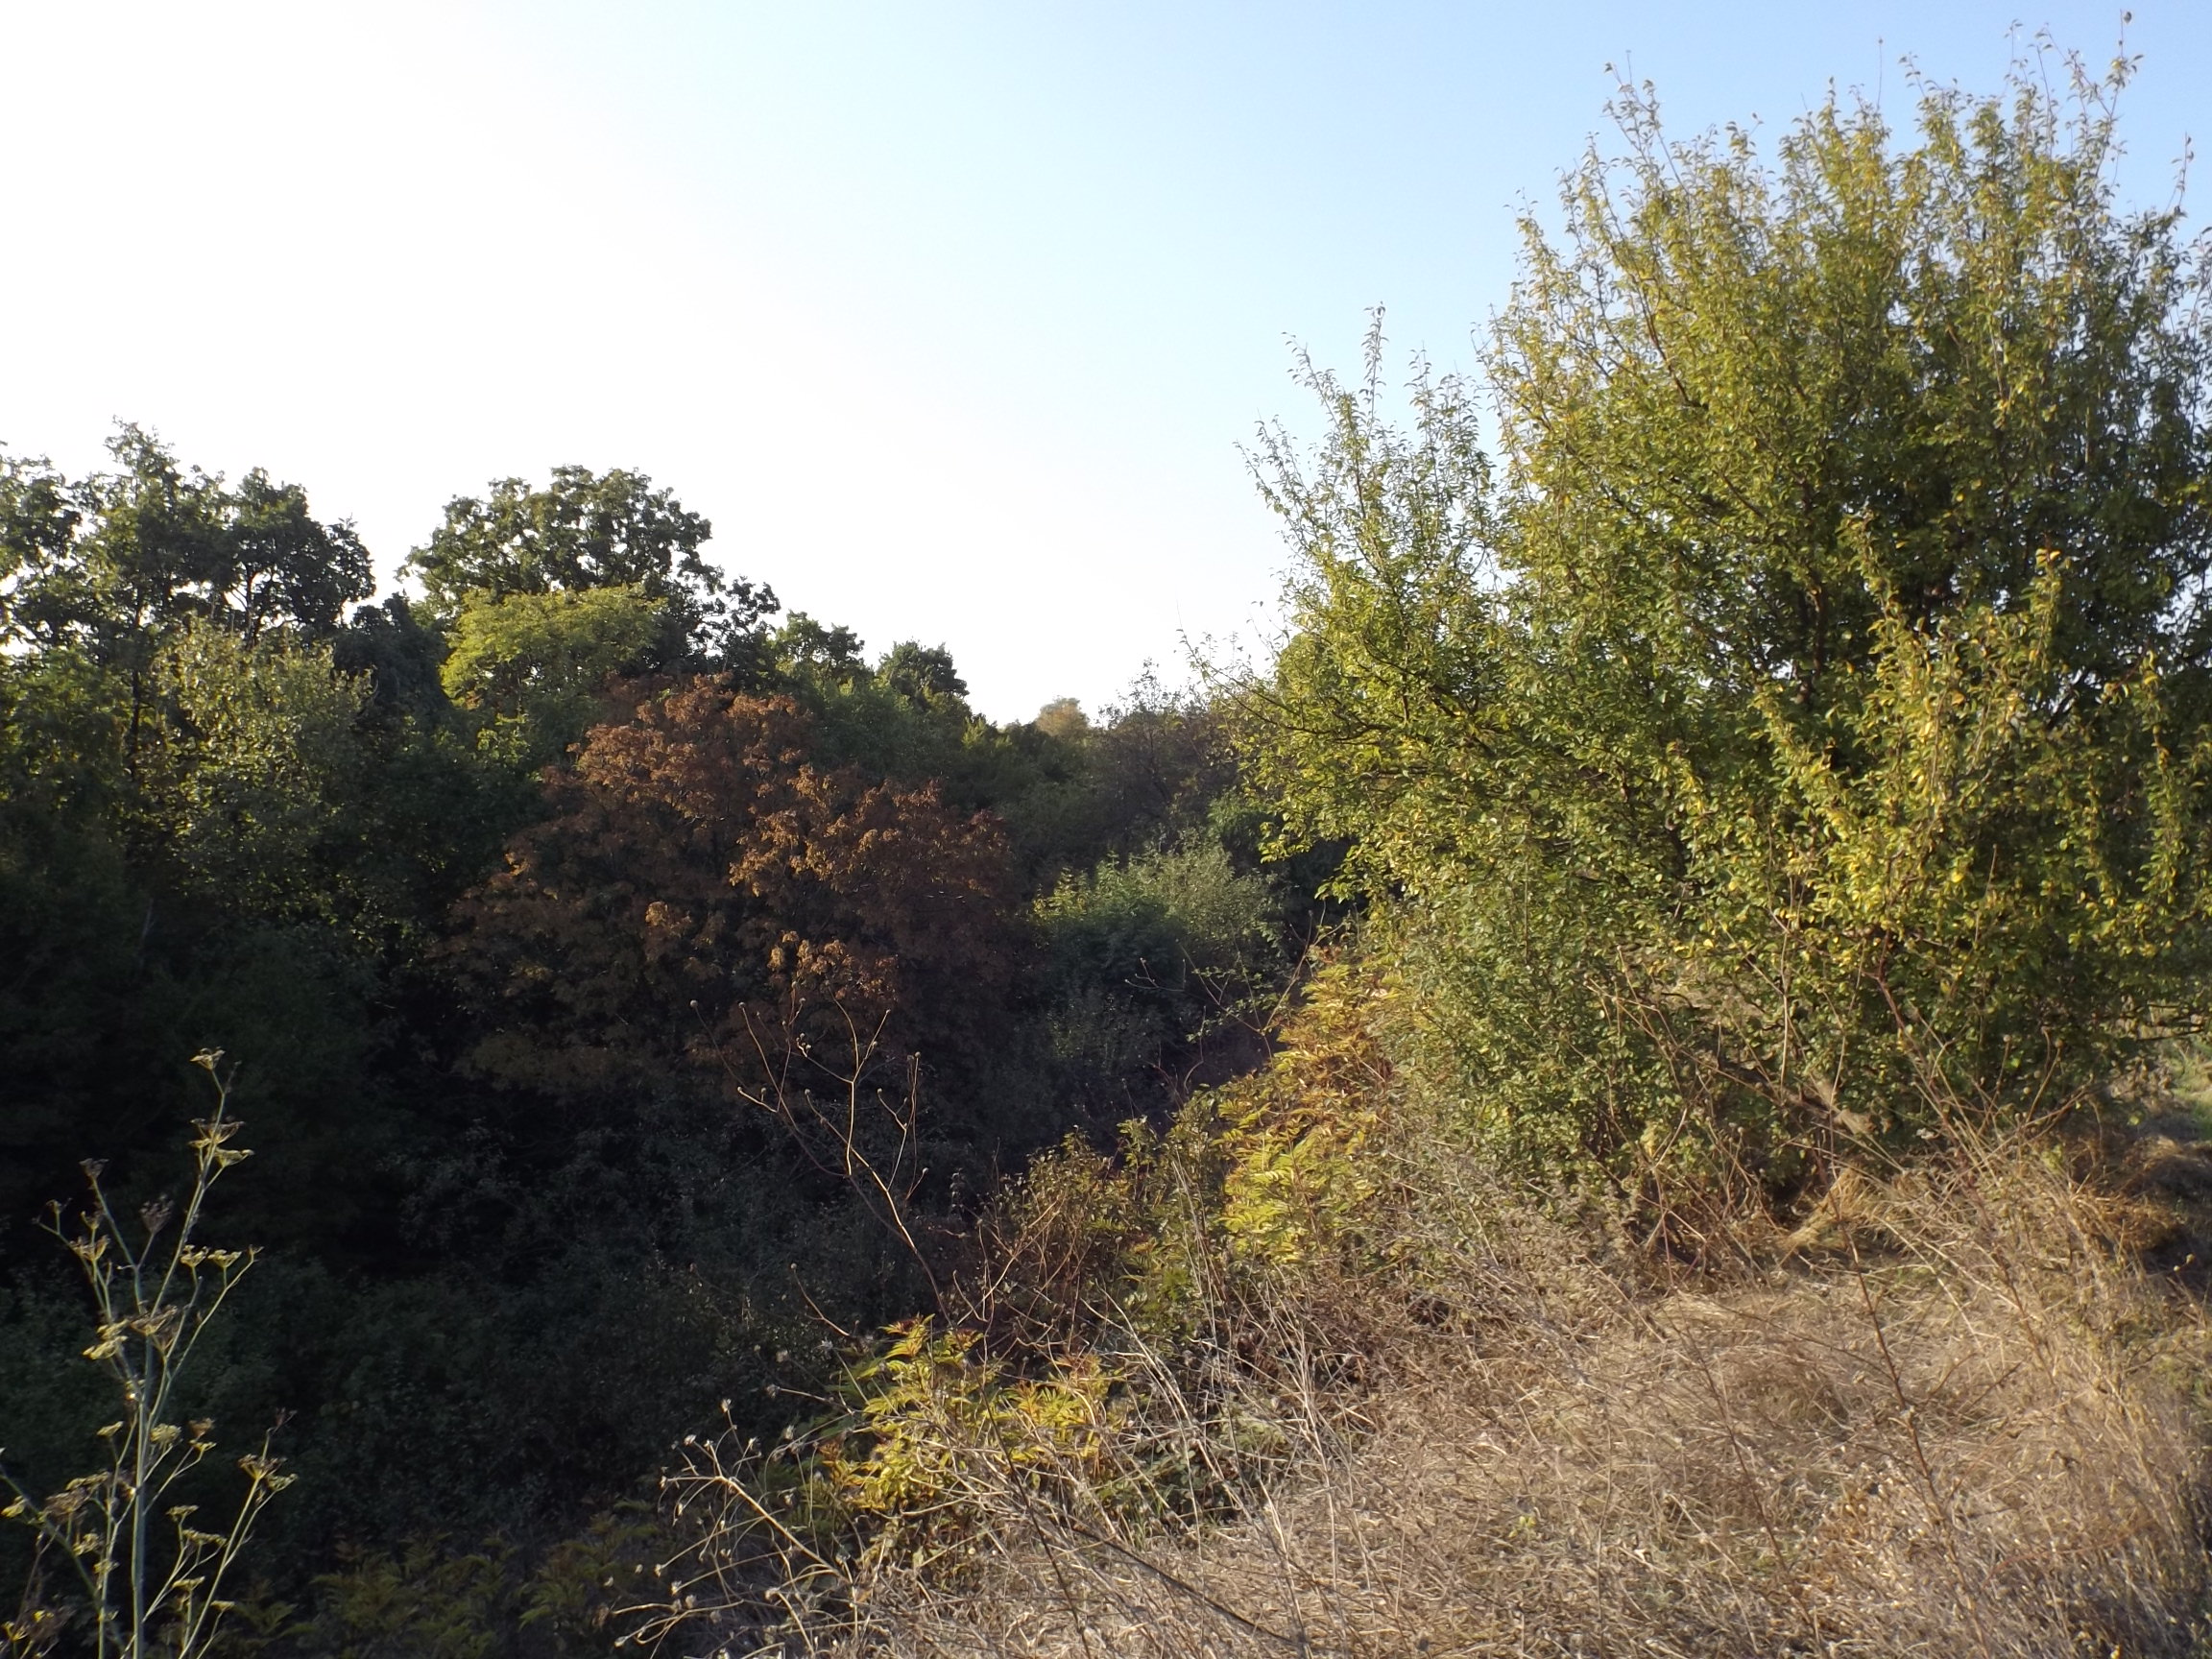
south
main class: Grassland
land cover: Grassland with sparse tree/shrub cover
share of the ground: > 75 %
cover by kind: herbaceous plants 90 %, broadleaved forest trees 5 %, shrubs 5 %
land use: Semi-natural and natural areas not in use
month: October
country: BG
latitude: 42.8931
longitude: 27.8776
